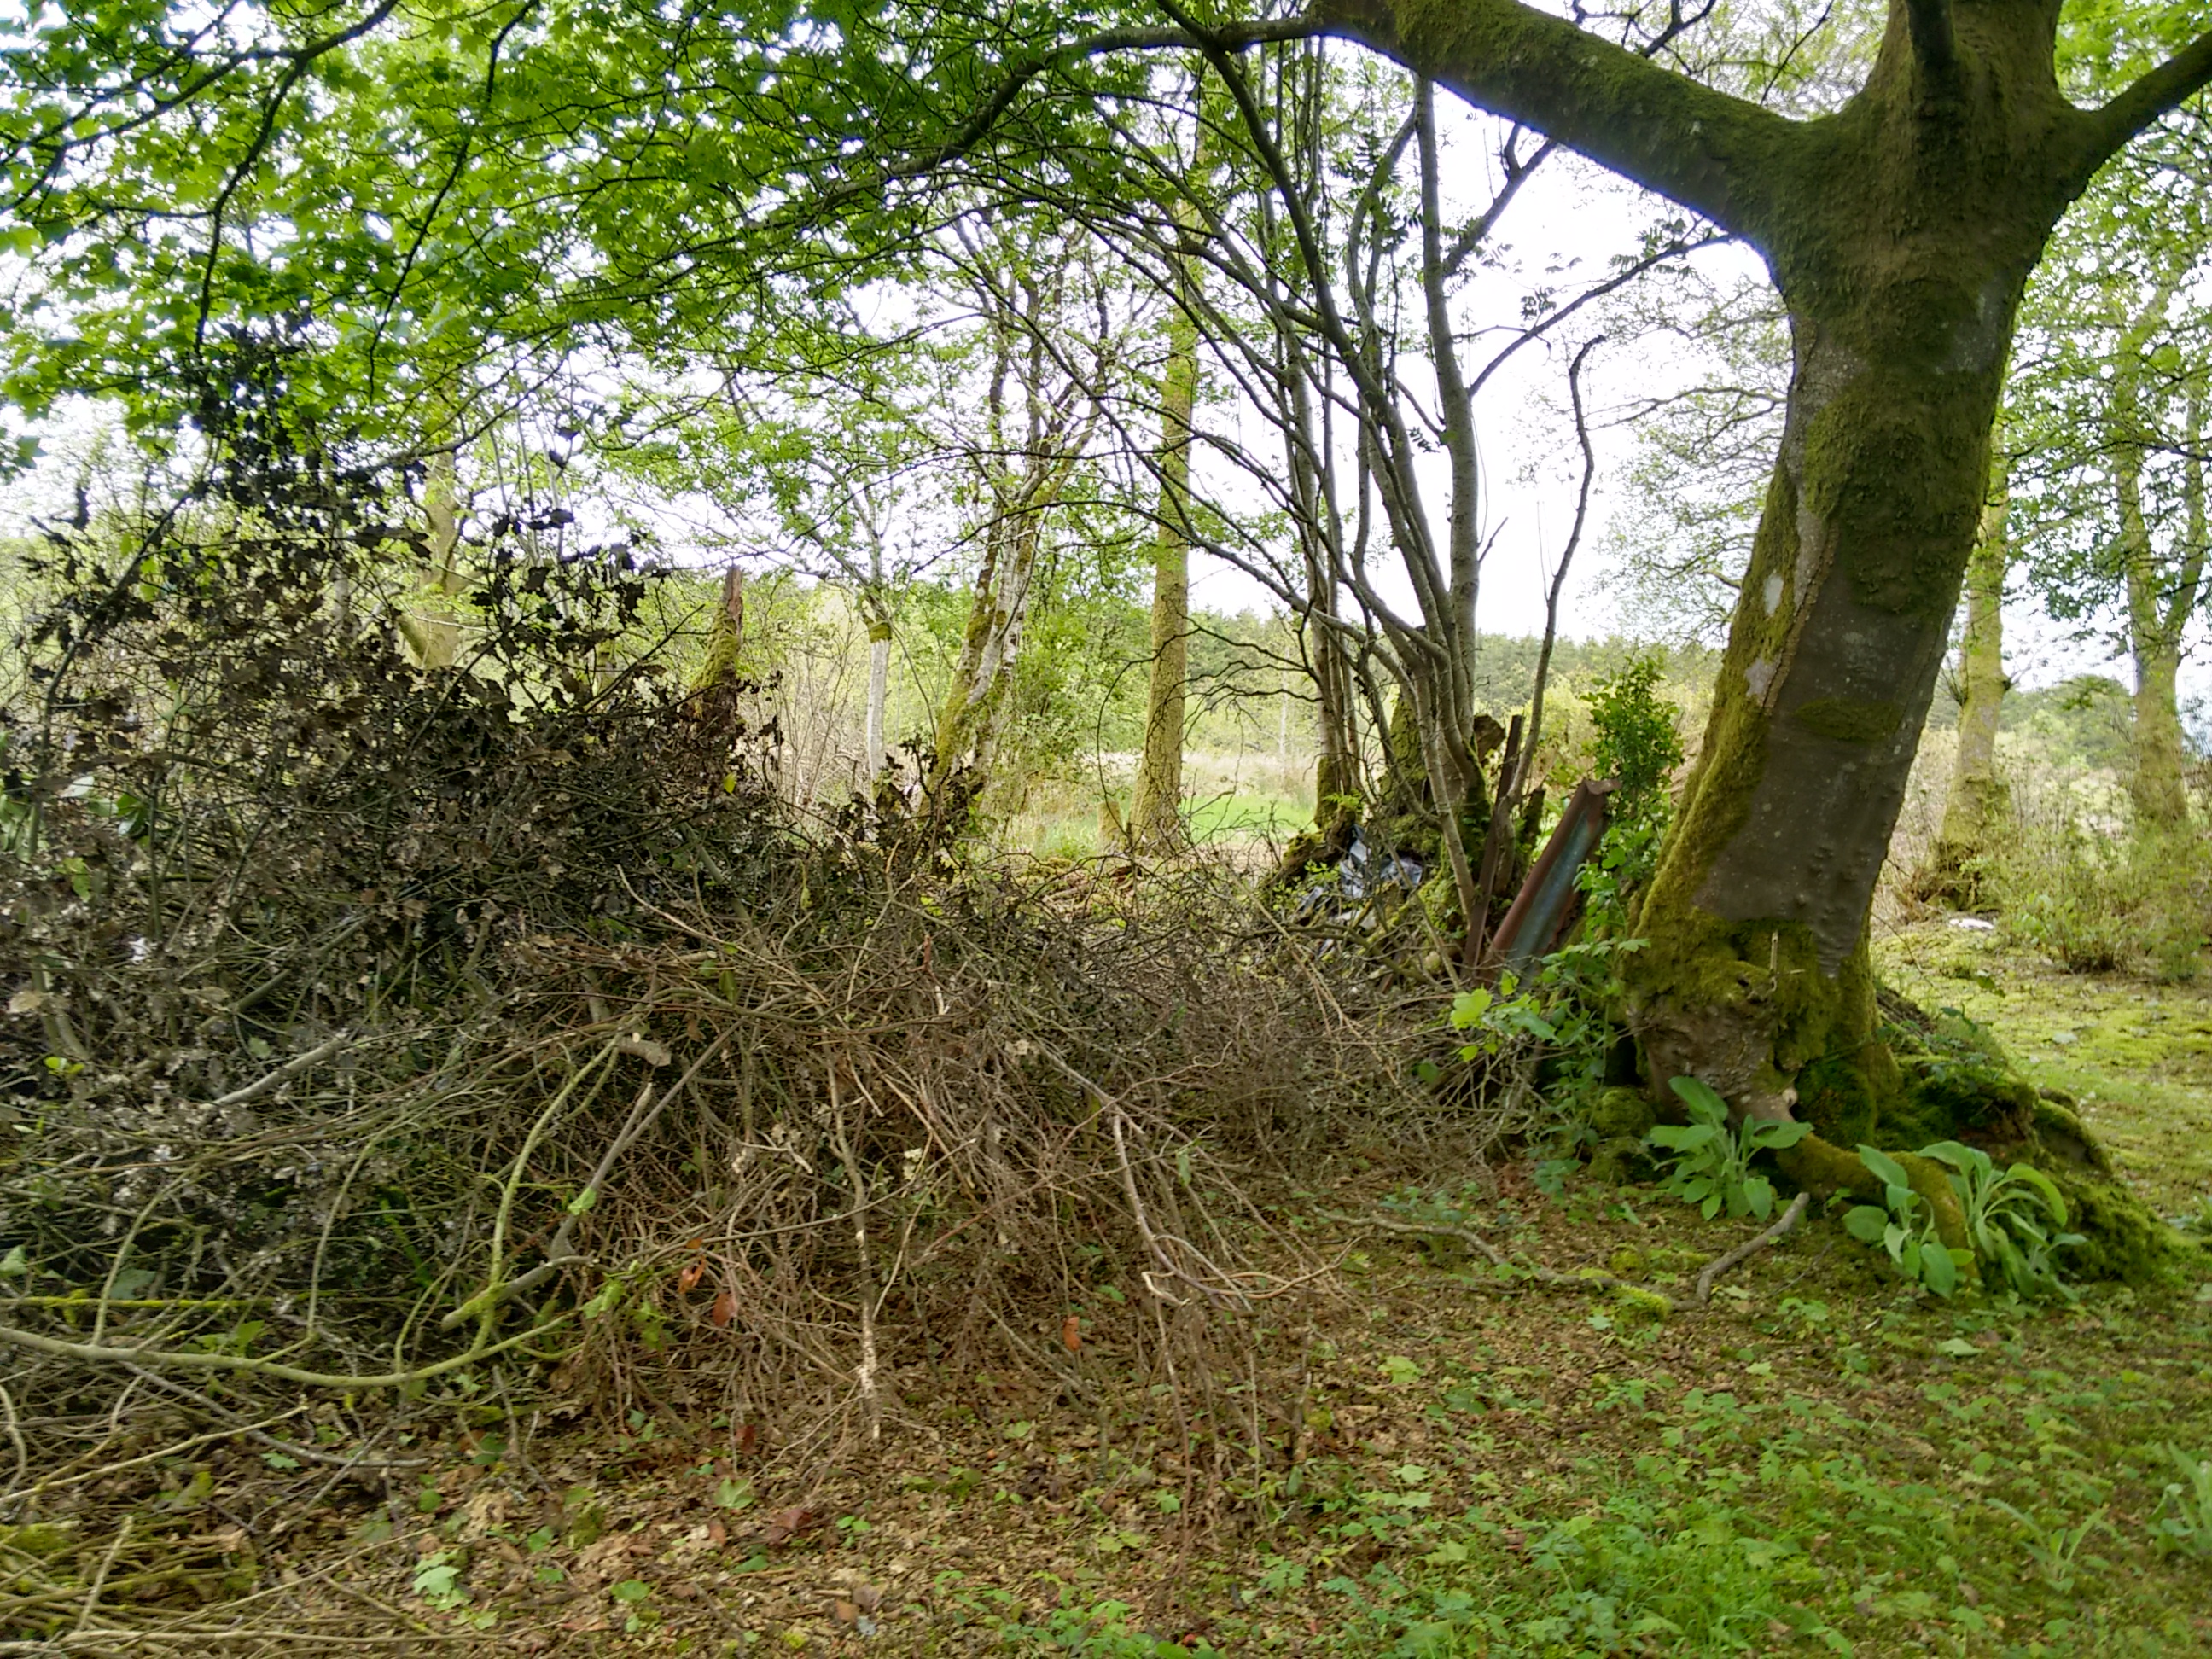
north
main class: Woodland
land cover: Broadleaved woodland
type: mesophytic deciduous forest
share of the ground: > 75 %
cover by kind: broadleaved forest trees 100 %
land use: Semi-natural and natural areas not in use
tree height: > 5 m
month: June
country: GB
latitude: 54.9894
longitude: -6.9692
